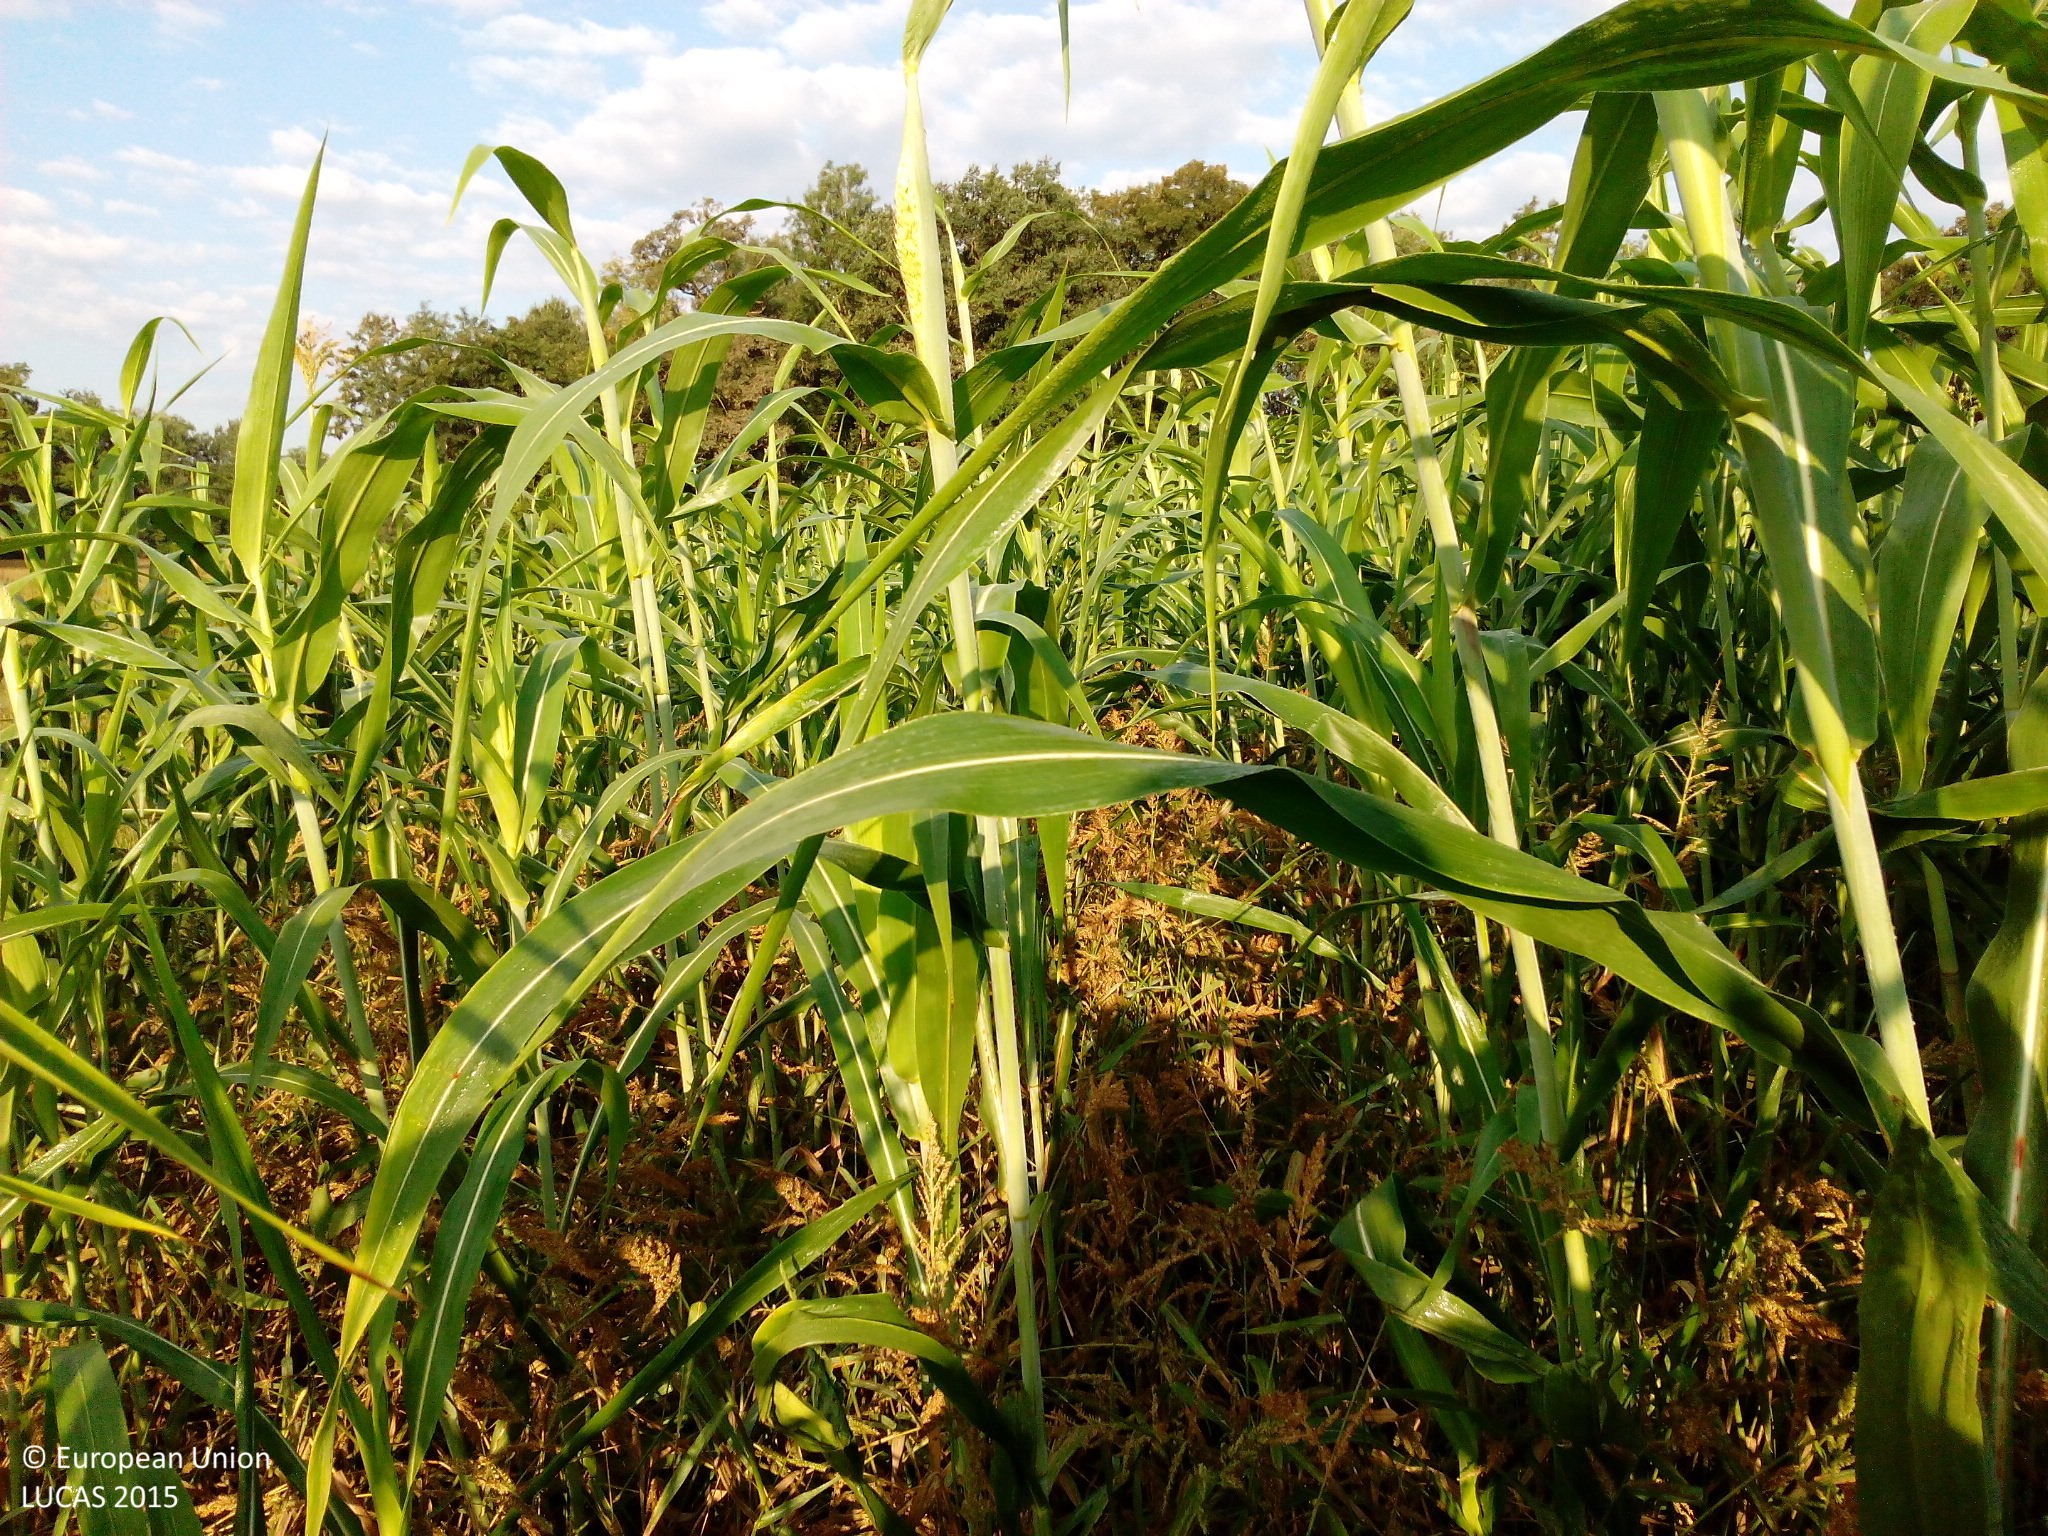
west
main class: Cropland
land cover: Maize
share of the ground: > 75 %
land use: Agriculture (excluding fallow land and kitchen gardens)
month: August
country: DE
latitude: 48.4930
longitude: 10.3111
